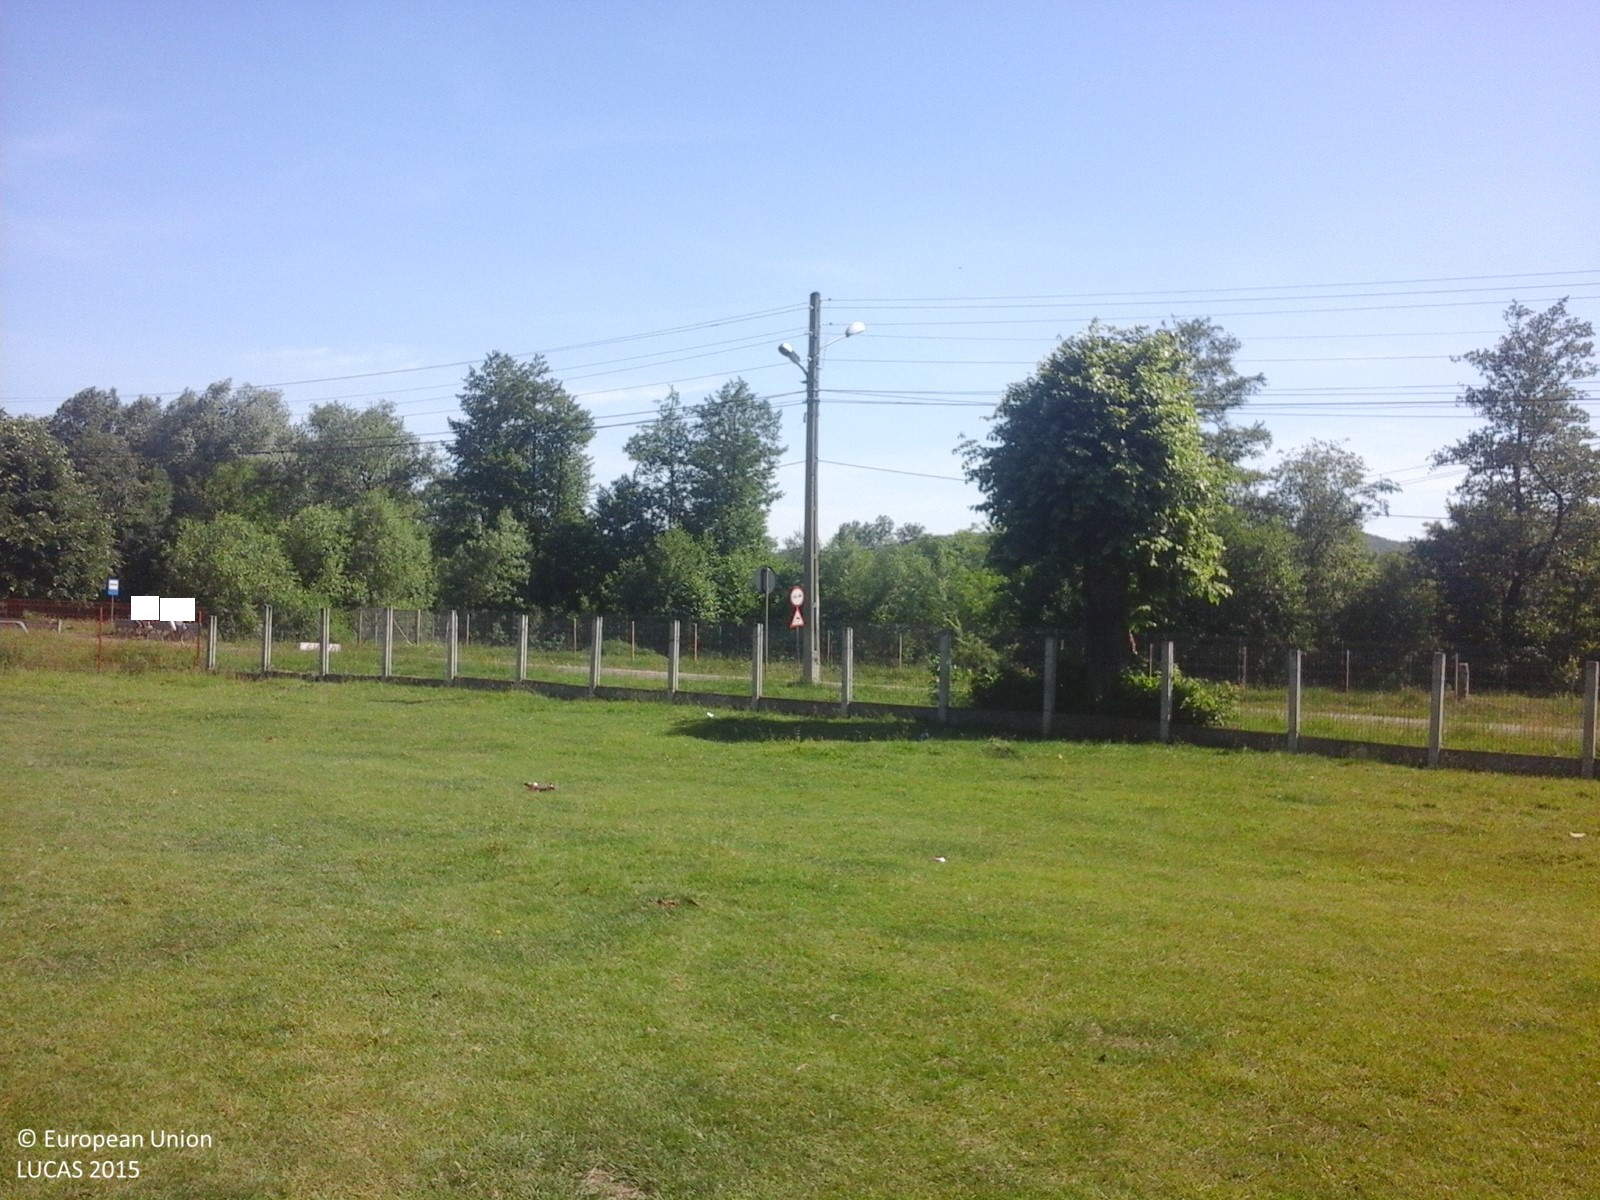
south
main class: Grassland
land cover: Grassland without tree/shrub cover
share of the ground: > 75 %
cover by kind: herbaceous plants 100 %
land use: Agriculture (excluding fallow land and kitchen gardens)
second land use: Amenities, museums, leisure
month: June
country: RO
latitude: 45.0469
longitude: 25.6273
